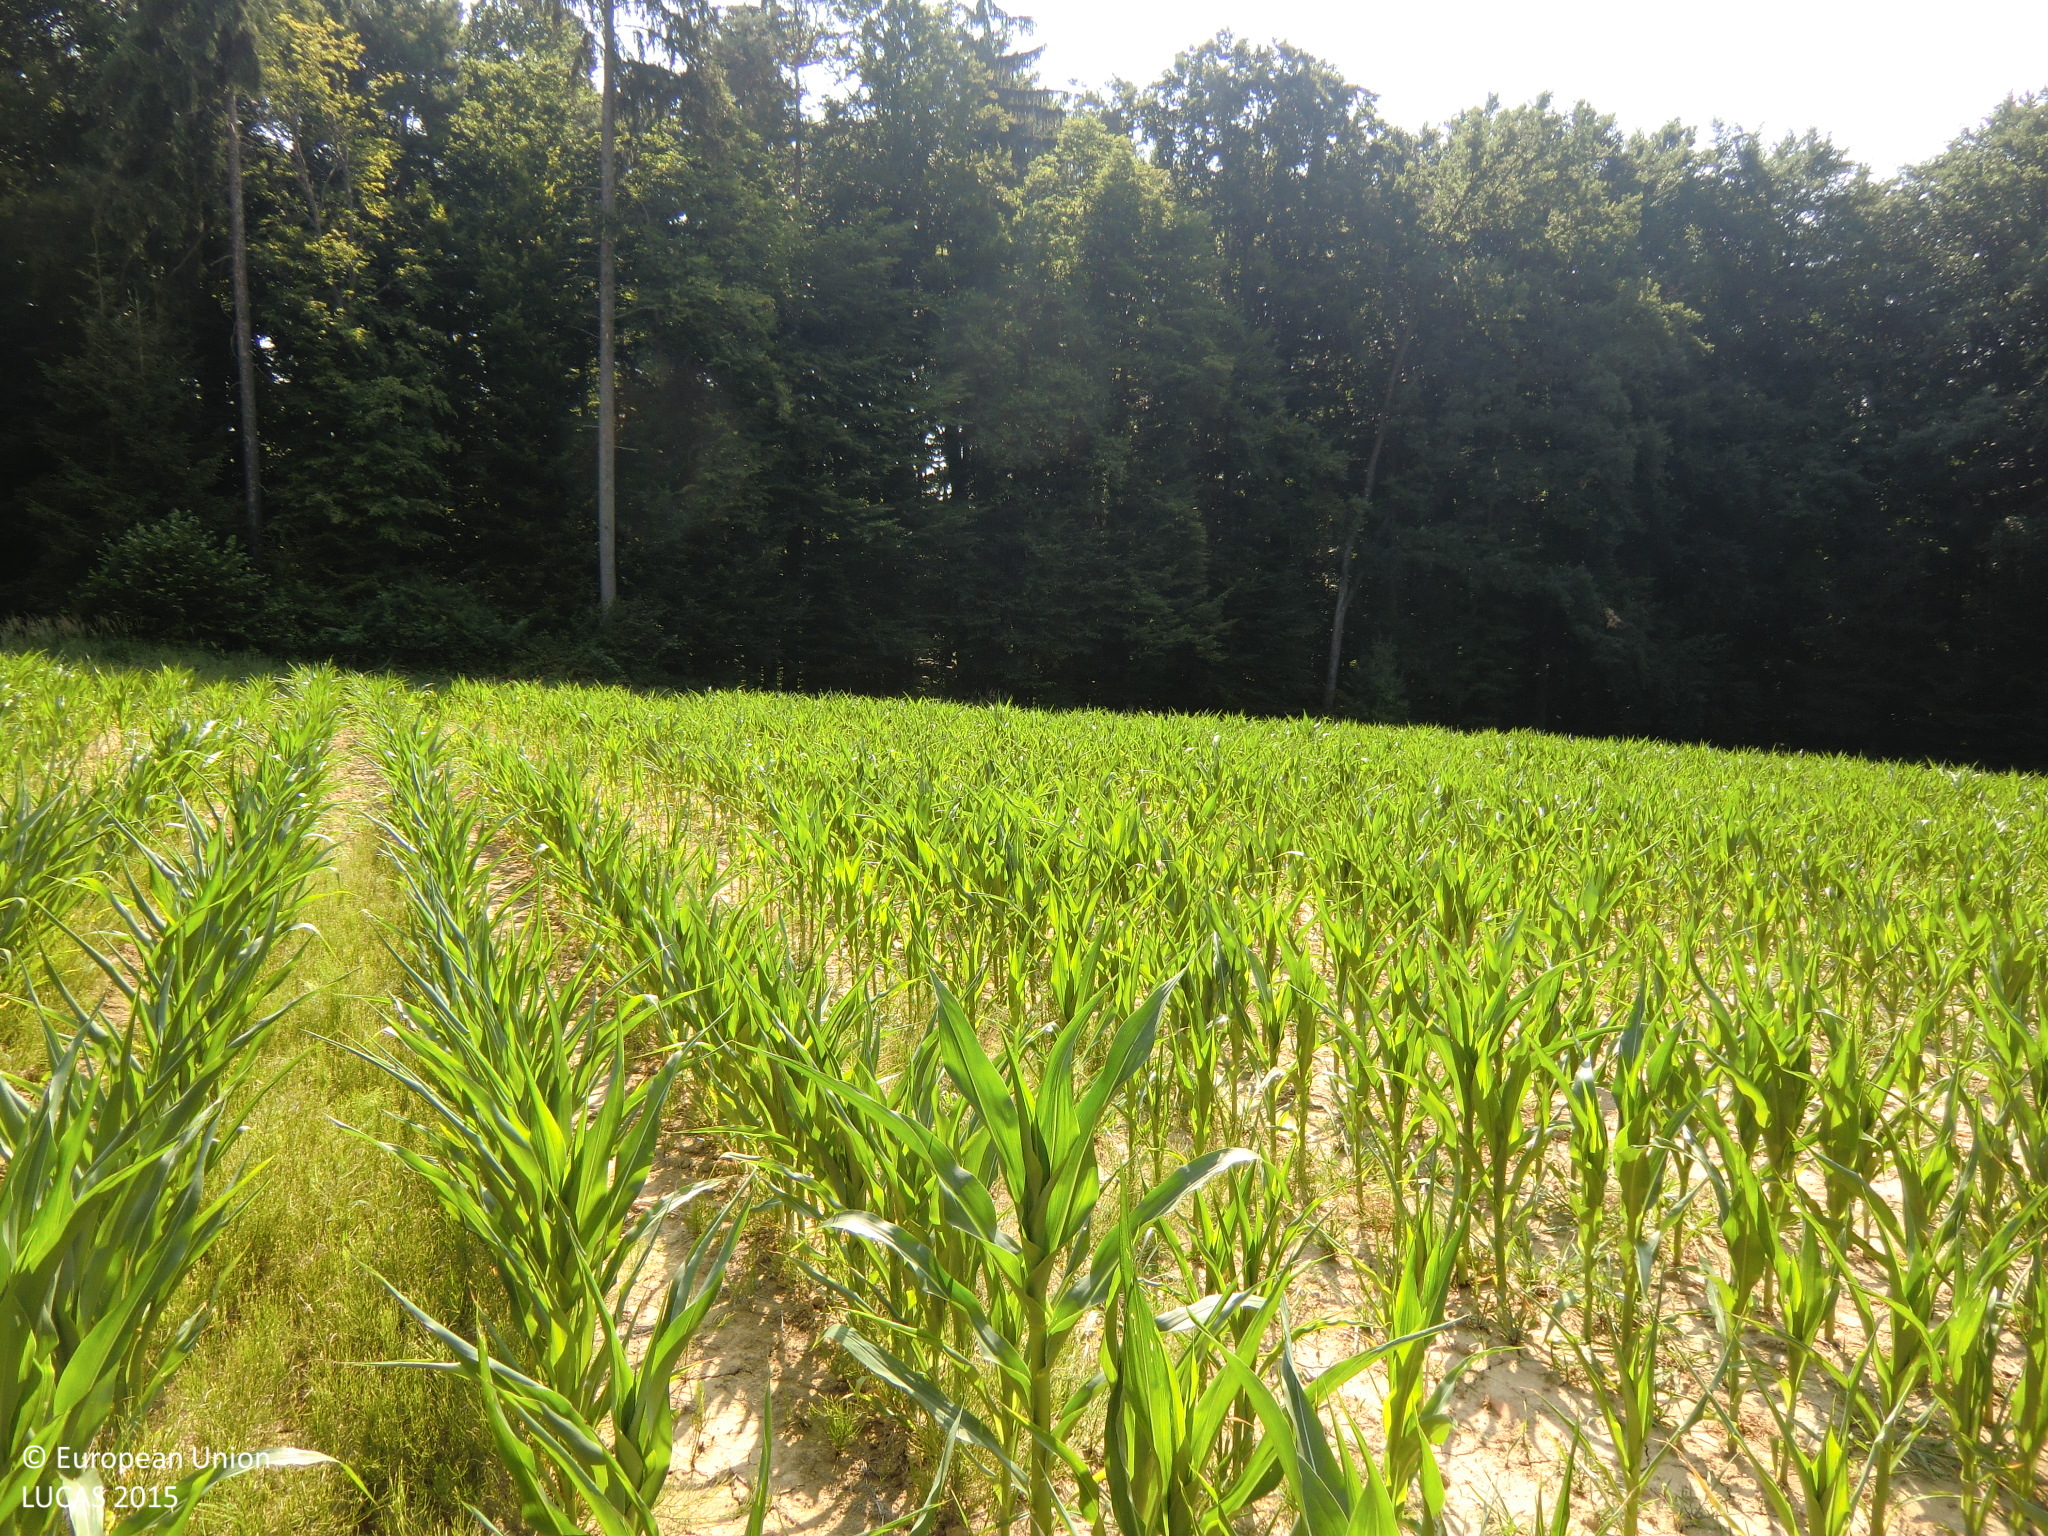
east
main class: Cropland
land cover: Maize
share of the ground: 50 - 75 %
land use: Agriculture (excluding fallow land and kitchen gardens)
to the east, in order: Maize; Grassland without tree/shrub cover; Spruce dominated mixed woodland; Ditches and canals; Tracks; Spruce dominated mixed woodland; Grassland without tree/shrub cover; Maize; Grass margins; Fences; Apple fruit
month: July
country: AT
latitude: 47.1539
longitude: 15.7379
